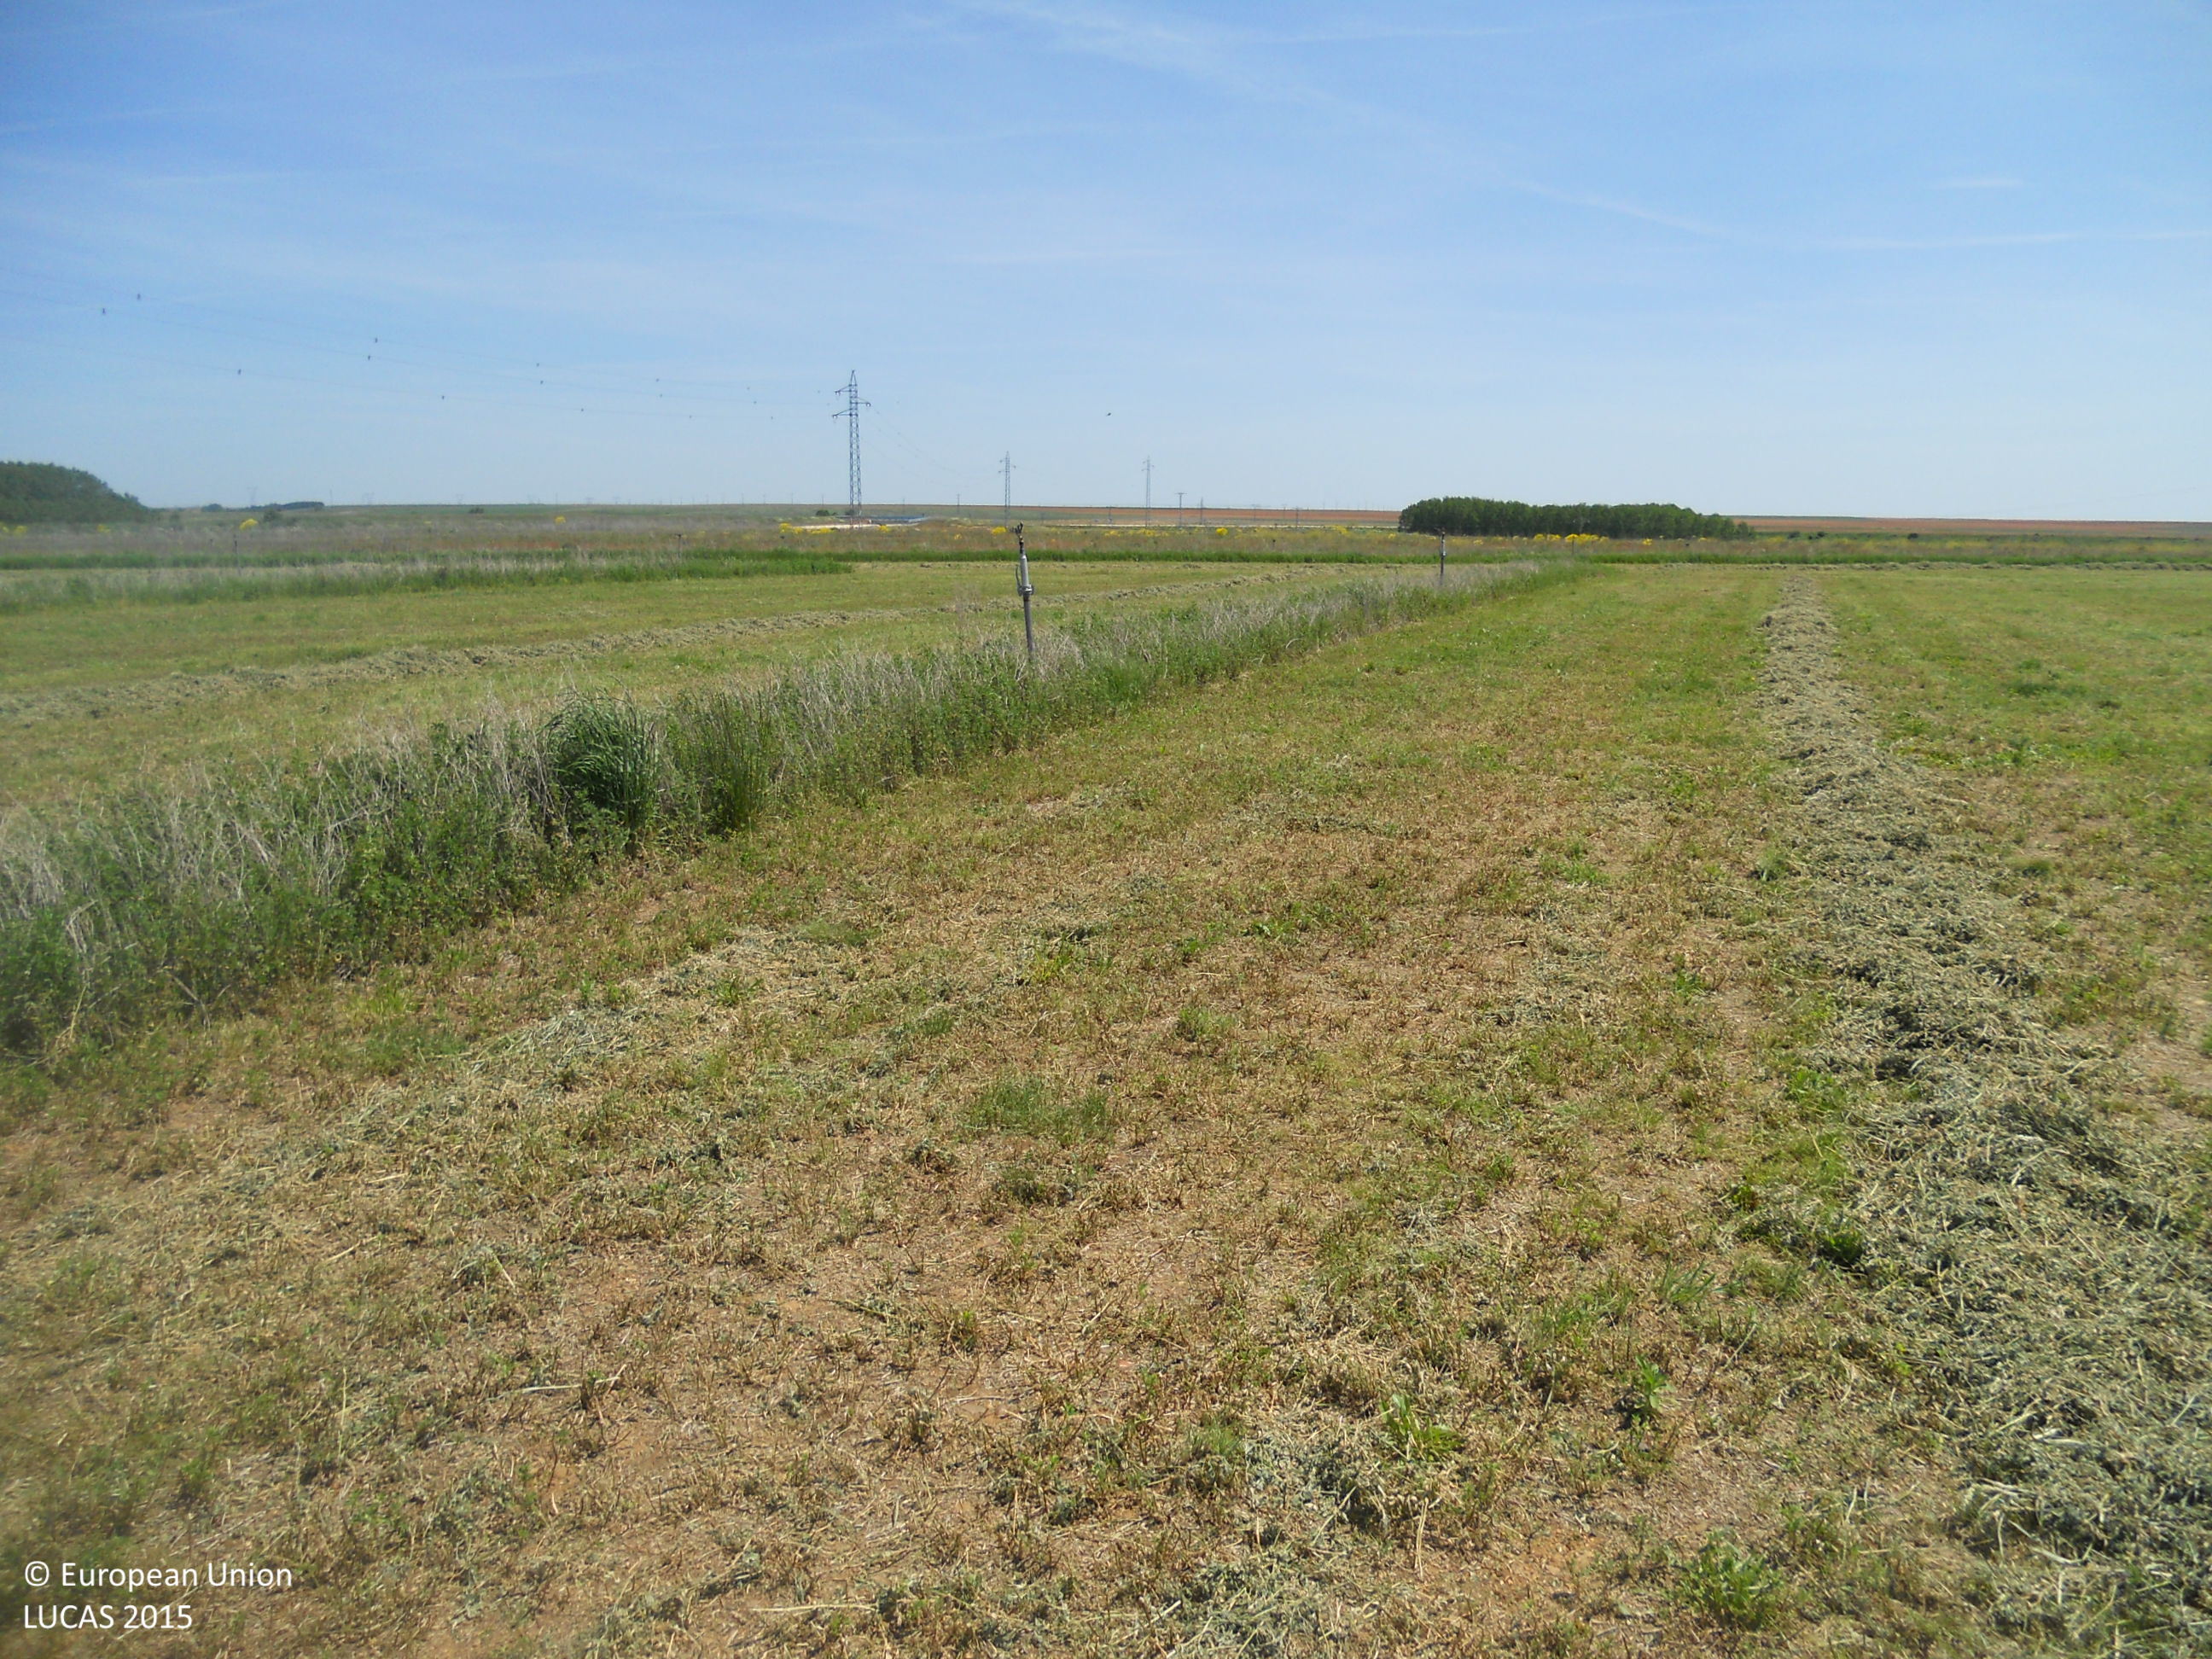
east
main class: Cropland
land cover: Lucerne
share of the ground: > 75 %
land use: Agriculture (excluding fallow land and kitchen gardens)
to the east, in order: Lucerne; Pine dominated coniferous woodland
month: May
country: ES
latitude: 42.4028
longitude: -5.2883
